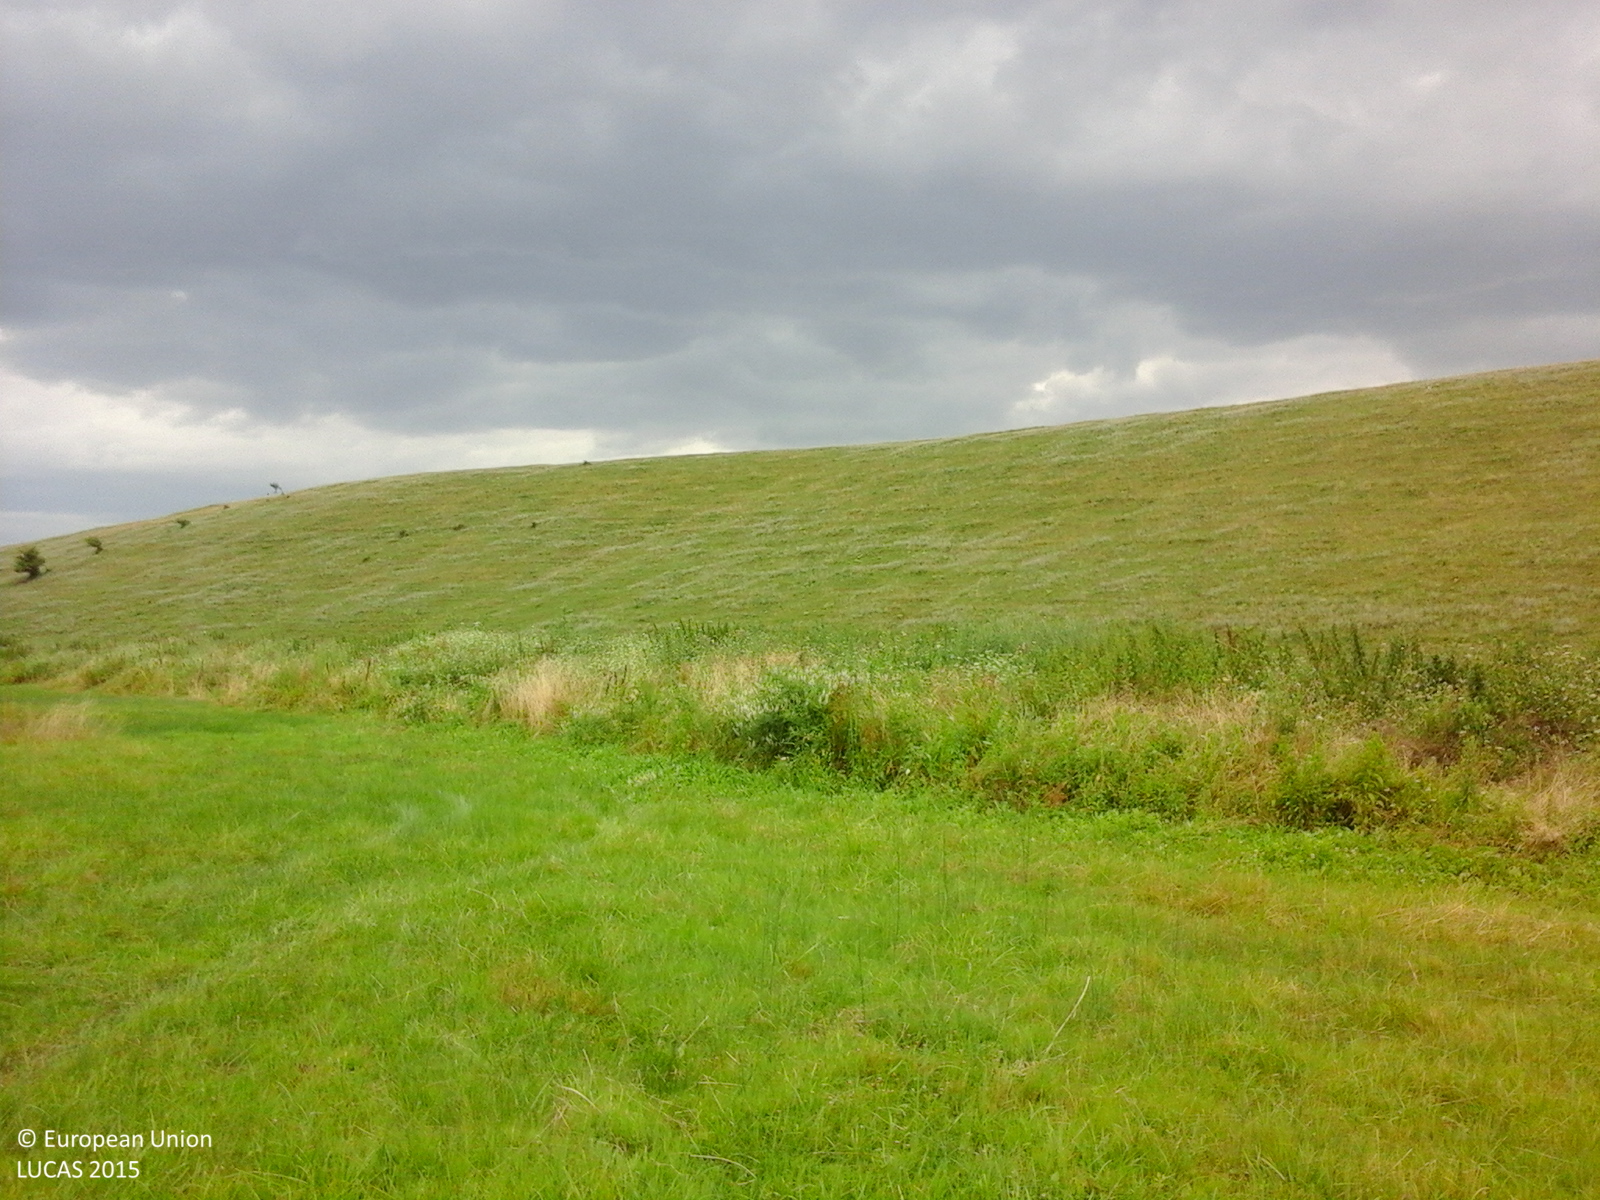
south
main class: Grassland
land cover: Grassland without tree/shrub cover
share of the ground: > 75 %
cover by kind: herbaceous plants 100 %
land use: Agriculture (excluding fallow land and kitchen gardens)
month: July
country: RO
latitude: 44.0143
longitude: 24.8041
